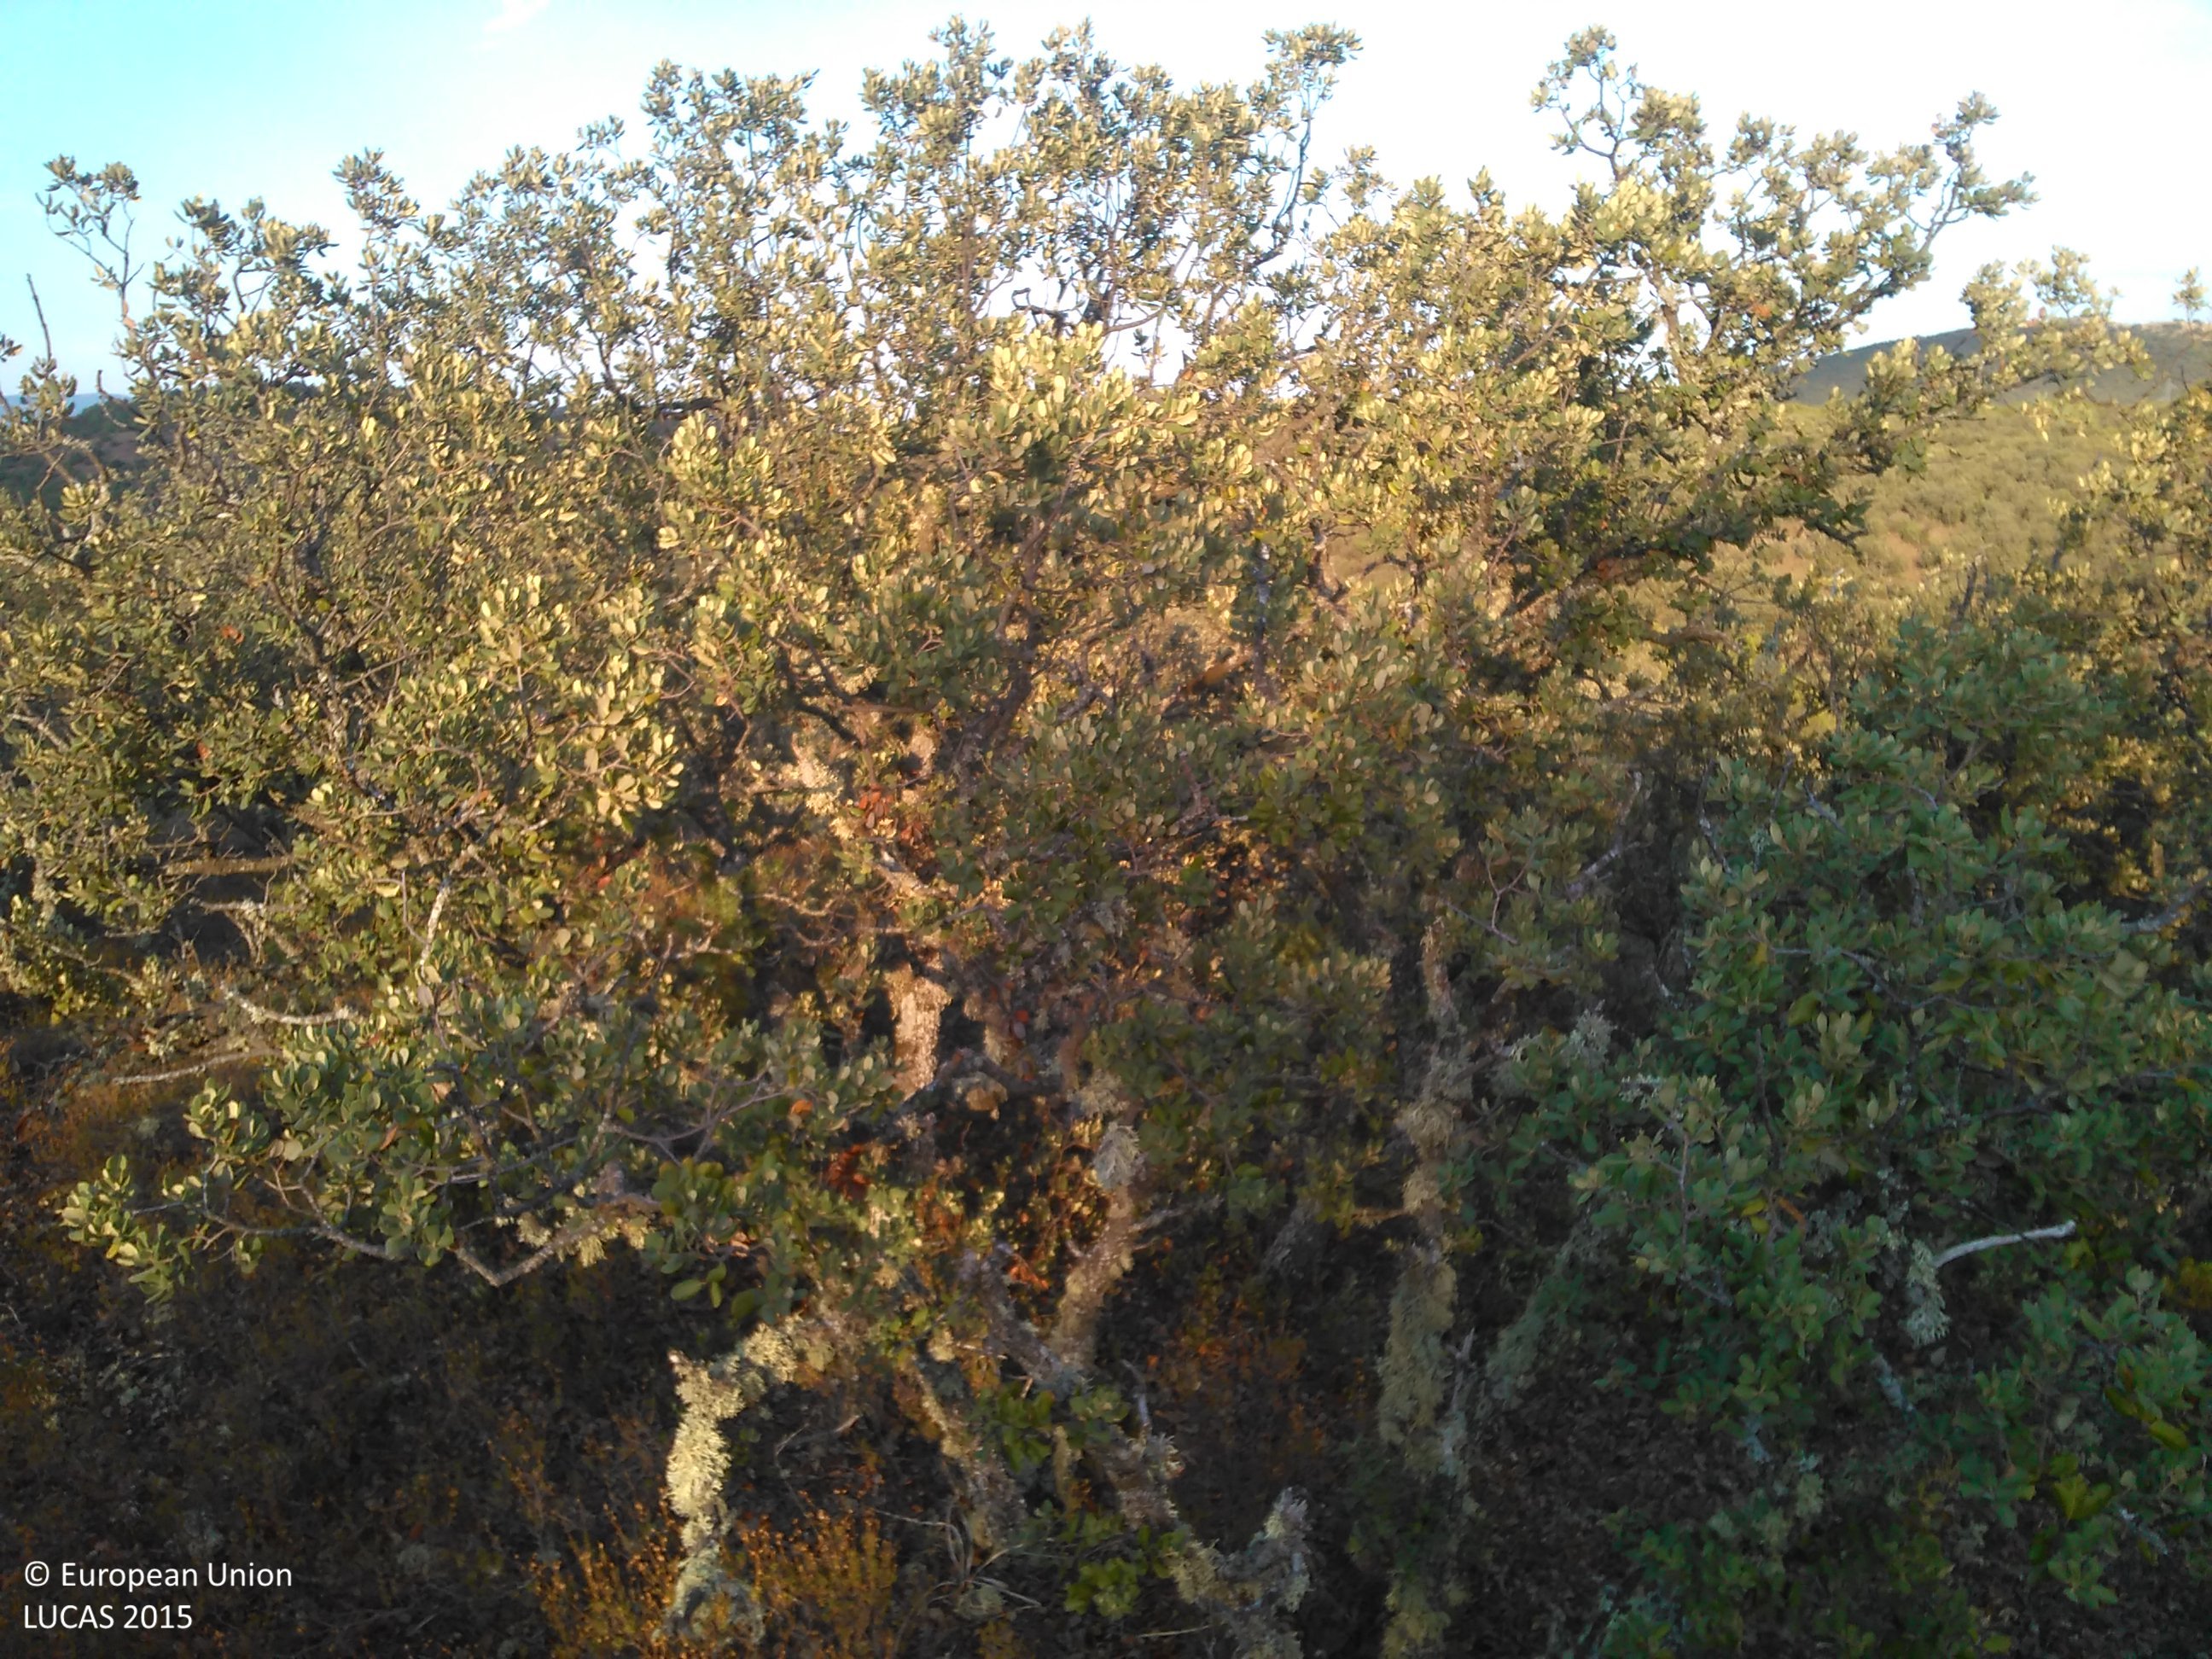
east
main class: Woodland
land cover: Broadleaved woodland
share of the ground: 50 - 75 %
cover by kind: broadleaved forest trees 50 %, shrubs 30 %, unconsolidated bare surface 20 %
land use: Semi-natural and natural areas not in use
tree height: < 5 m
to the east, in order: Broadleaved woodland; Pine dominated coniferous woodland; Broadleaved woodland
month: July
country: ES
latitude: 41.4226
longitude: -1.8858
